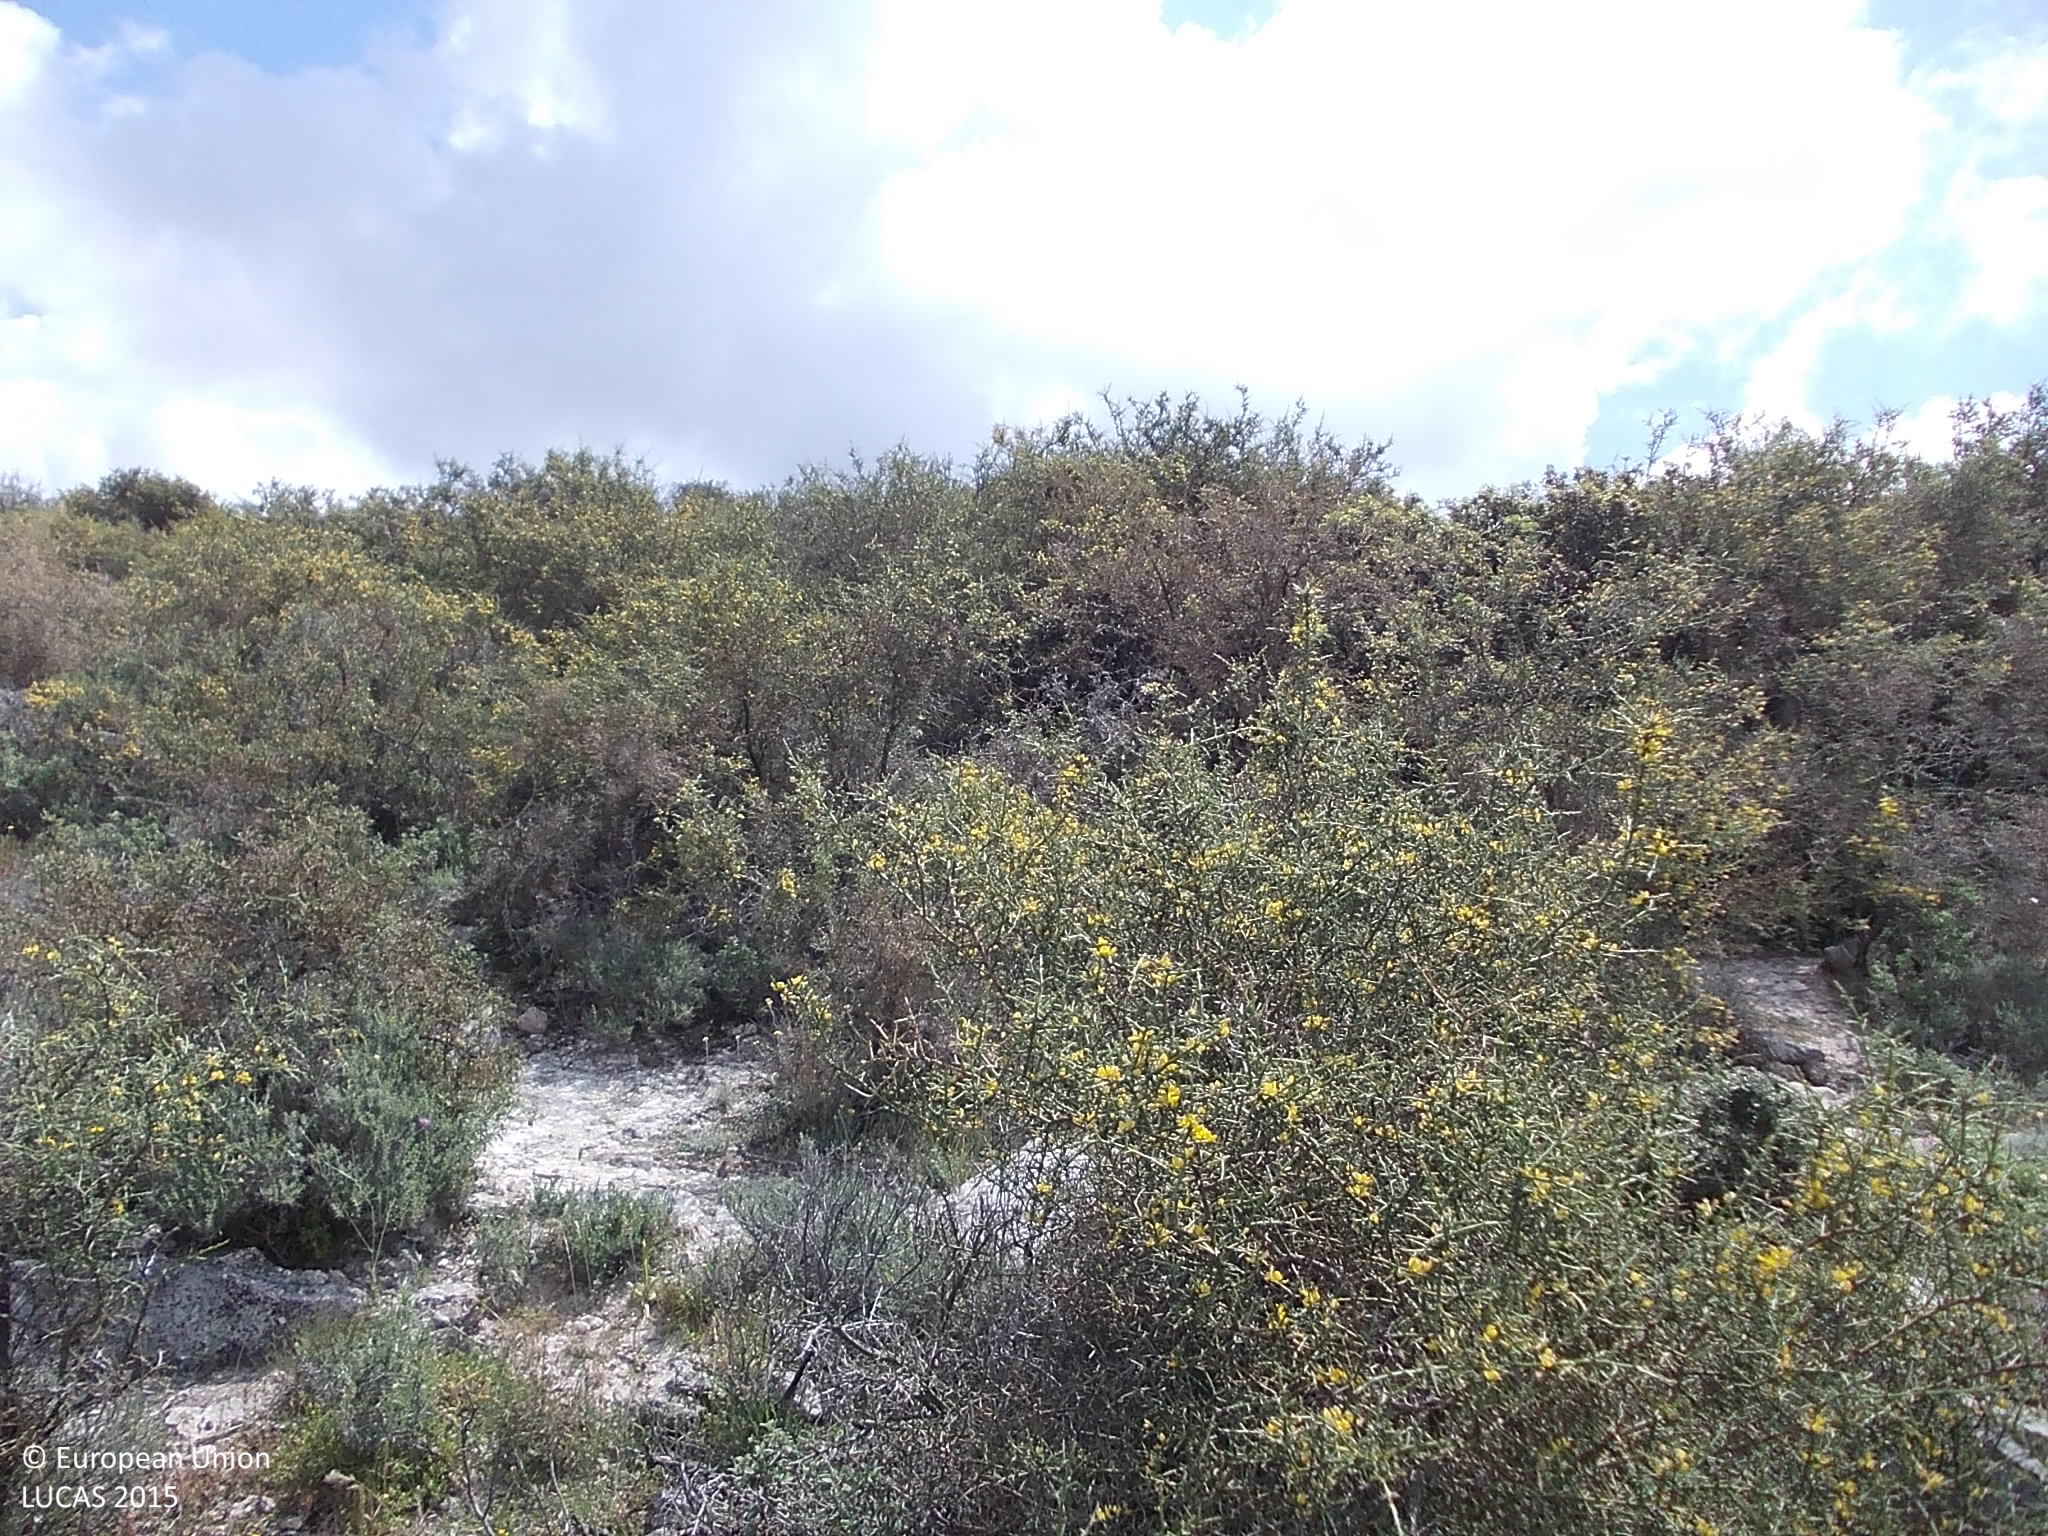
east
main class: Shrubland
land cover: Shrubland without tree cover
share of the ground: > 75 %
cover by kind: shrubs 80 %, unconsolidated bare surface 20 %
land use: Semi-natural and natural areas not in use
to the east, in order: Shrubland without tree cover; Dry stone walls; Grassland with sparse tree/shrub cover; Shrubland without tree cover; Fences; Tracks; Grassland with sparse tree/shrub cover
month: April
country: CY
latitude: 34.7104
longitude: 32.8127
